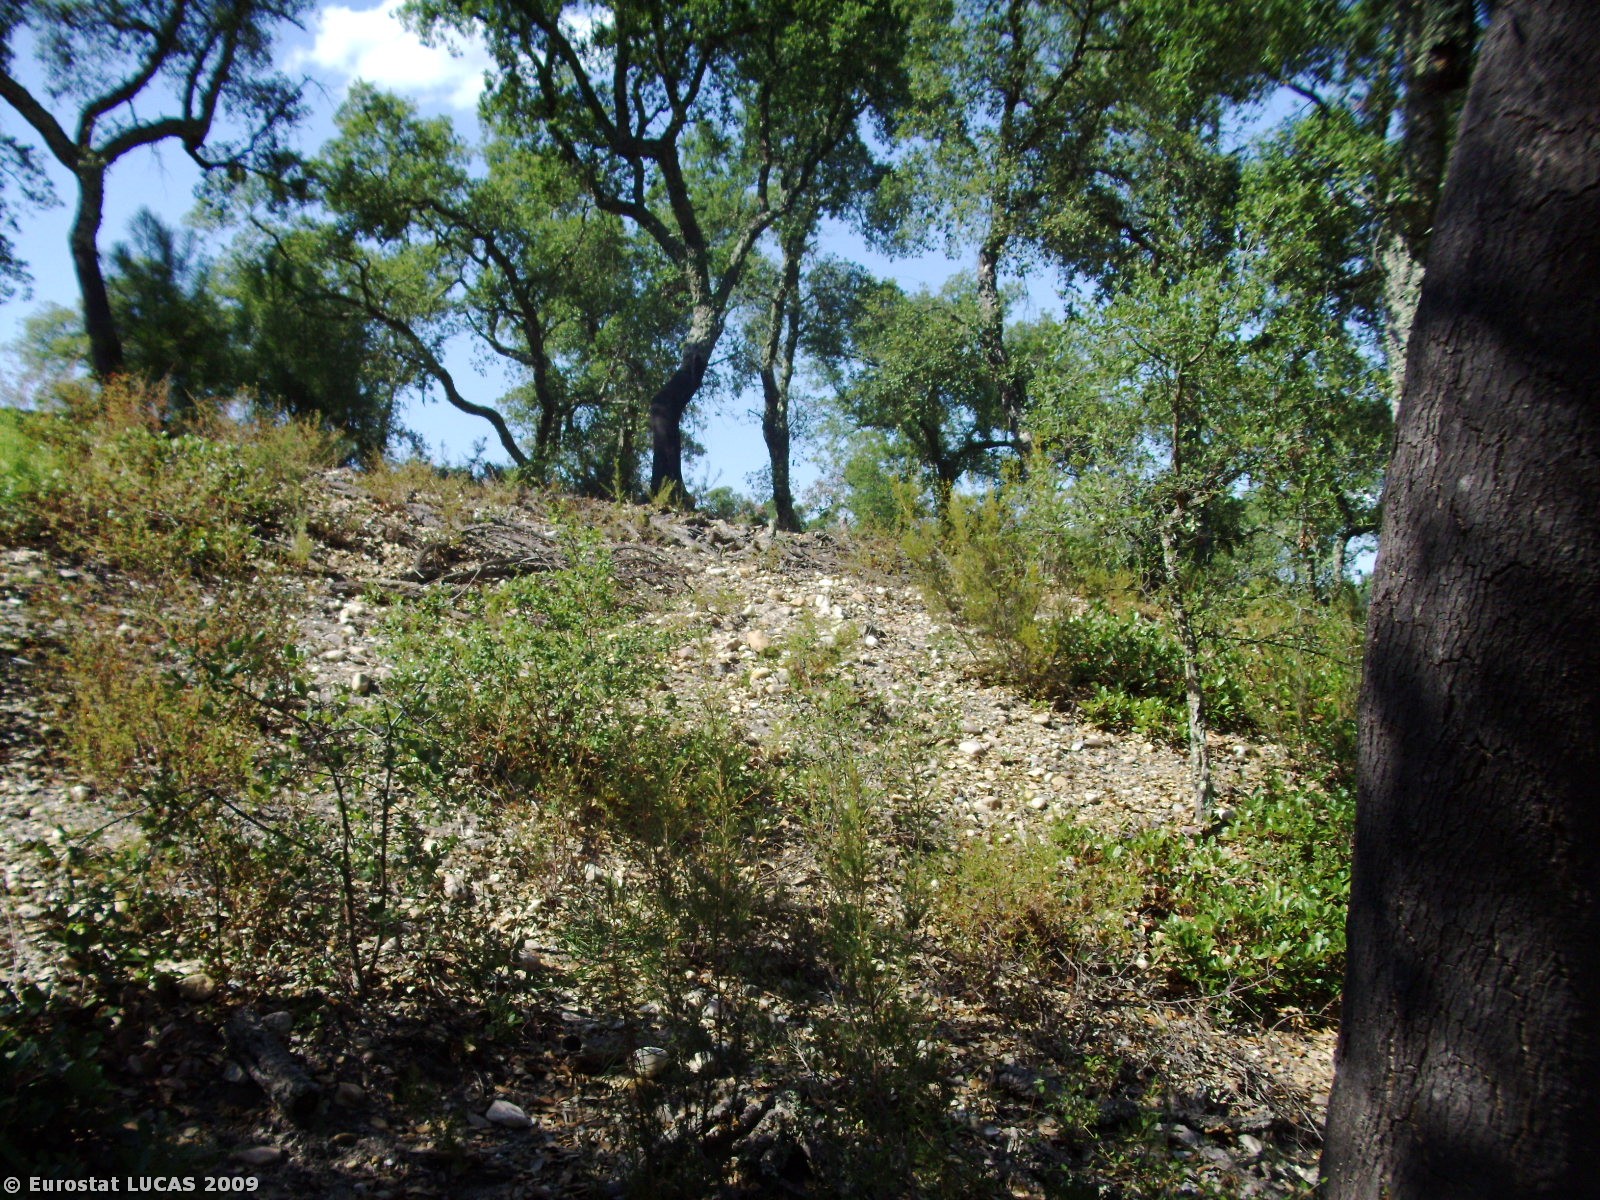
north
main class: Woodland
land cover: Broadleaved woodland
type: broadleaved evergreen forest
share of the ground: > 75 %
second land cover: Spontaneously vegetated surfaces
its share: 10 - 25 %
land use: Forestry
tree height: > 5 m
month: August
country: PT
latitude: 39.3132
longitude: -8.0692
